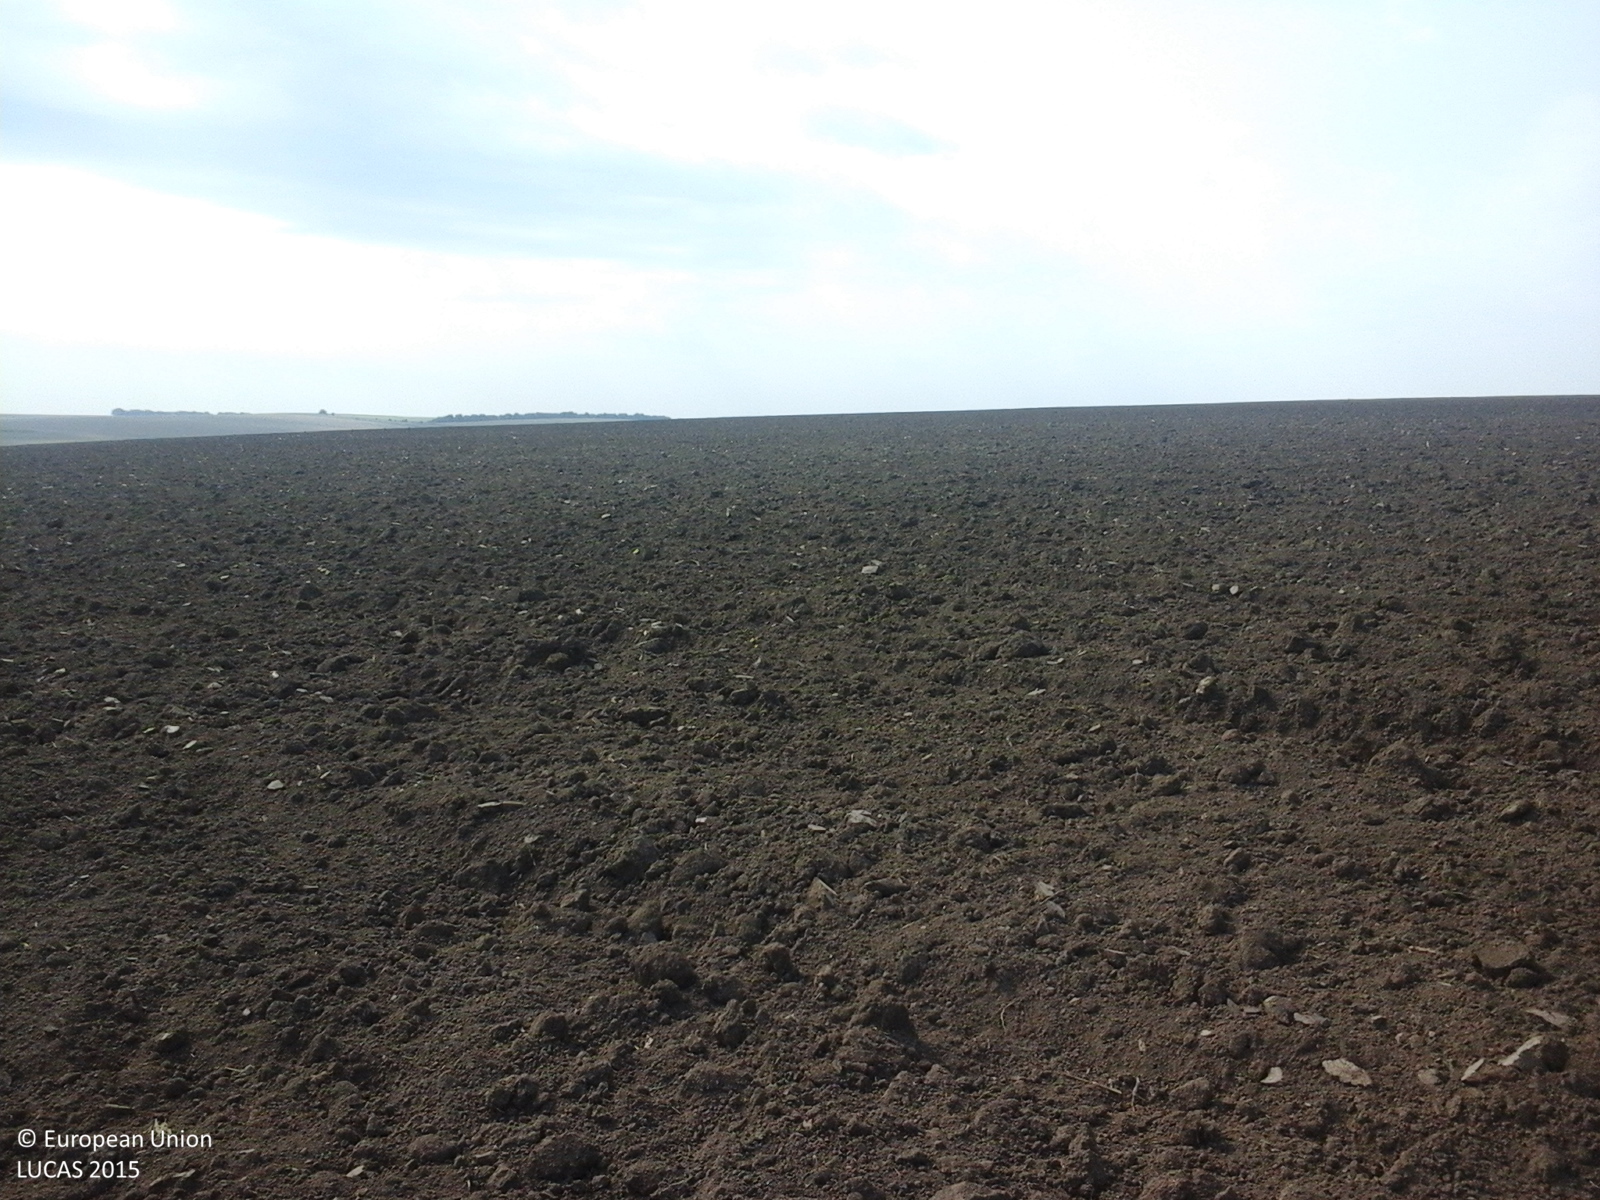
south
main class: Cropland
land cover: Common wheat
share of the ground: < 10 %
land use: Agriculture (excluding fallow land and kitchen gardens)
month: August
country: RO
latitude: 43.8140
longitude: 28.0919
